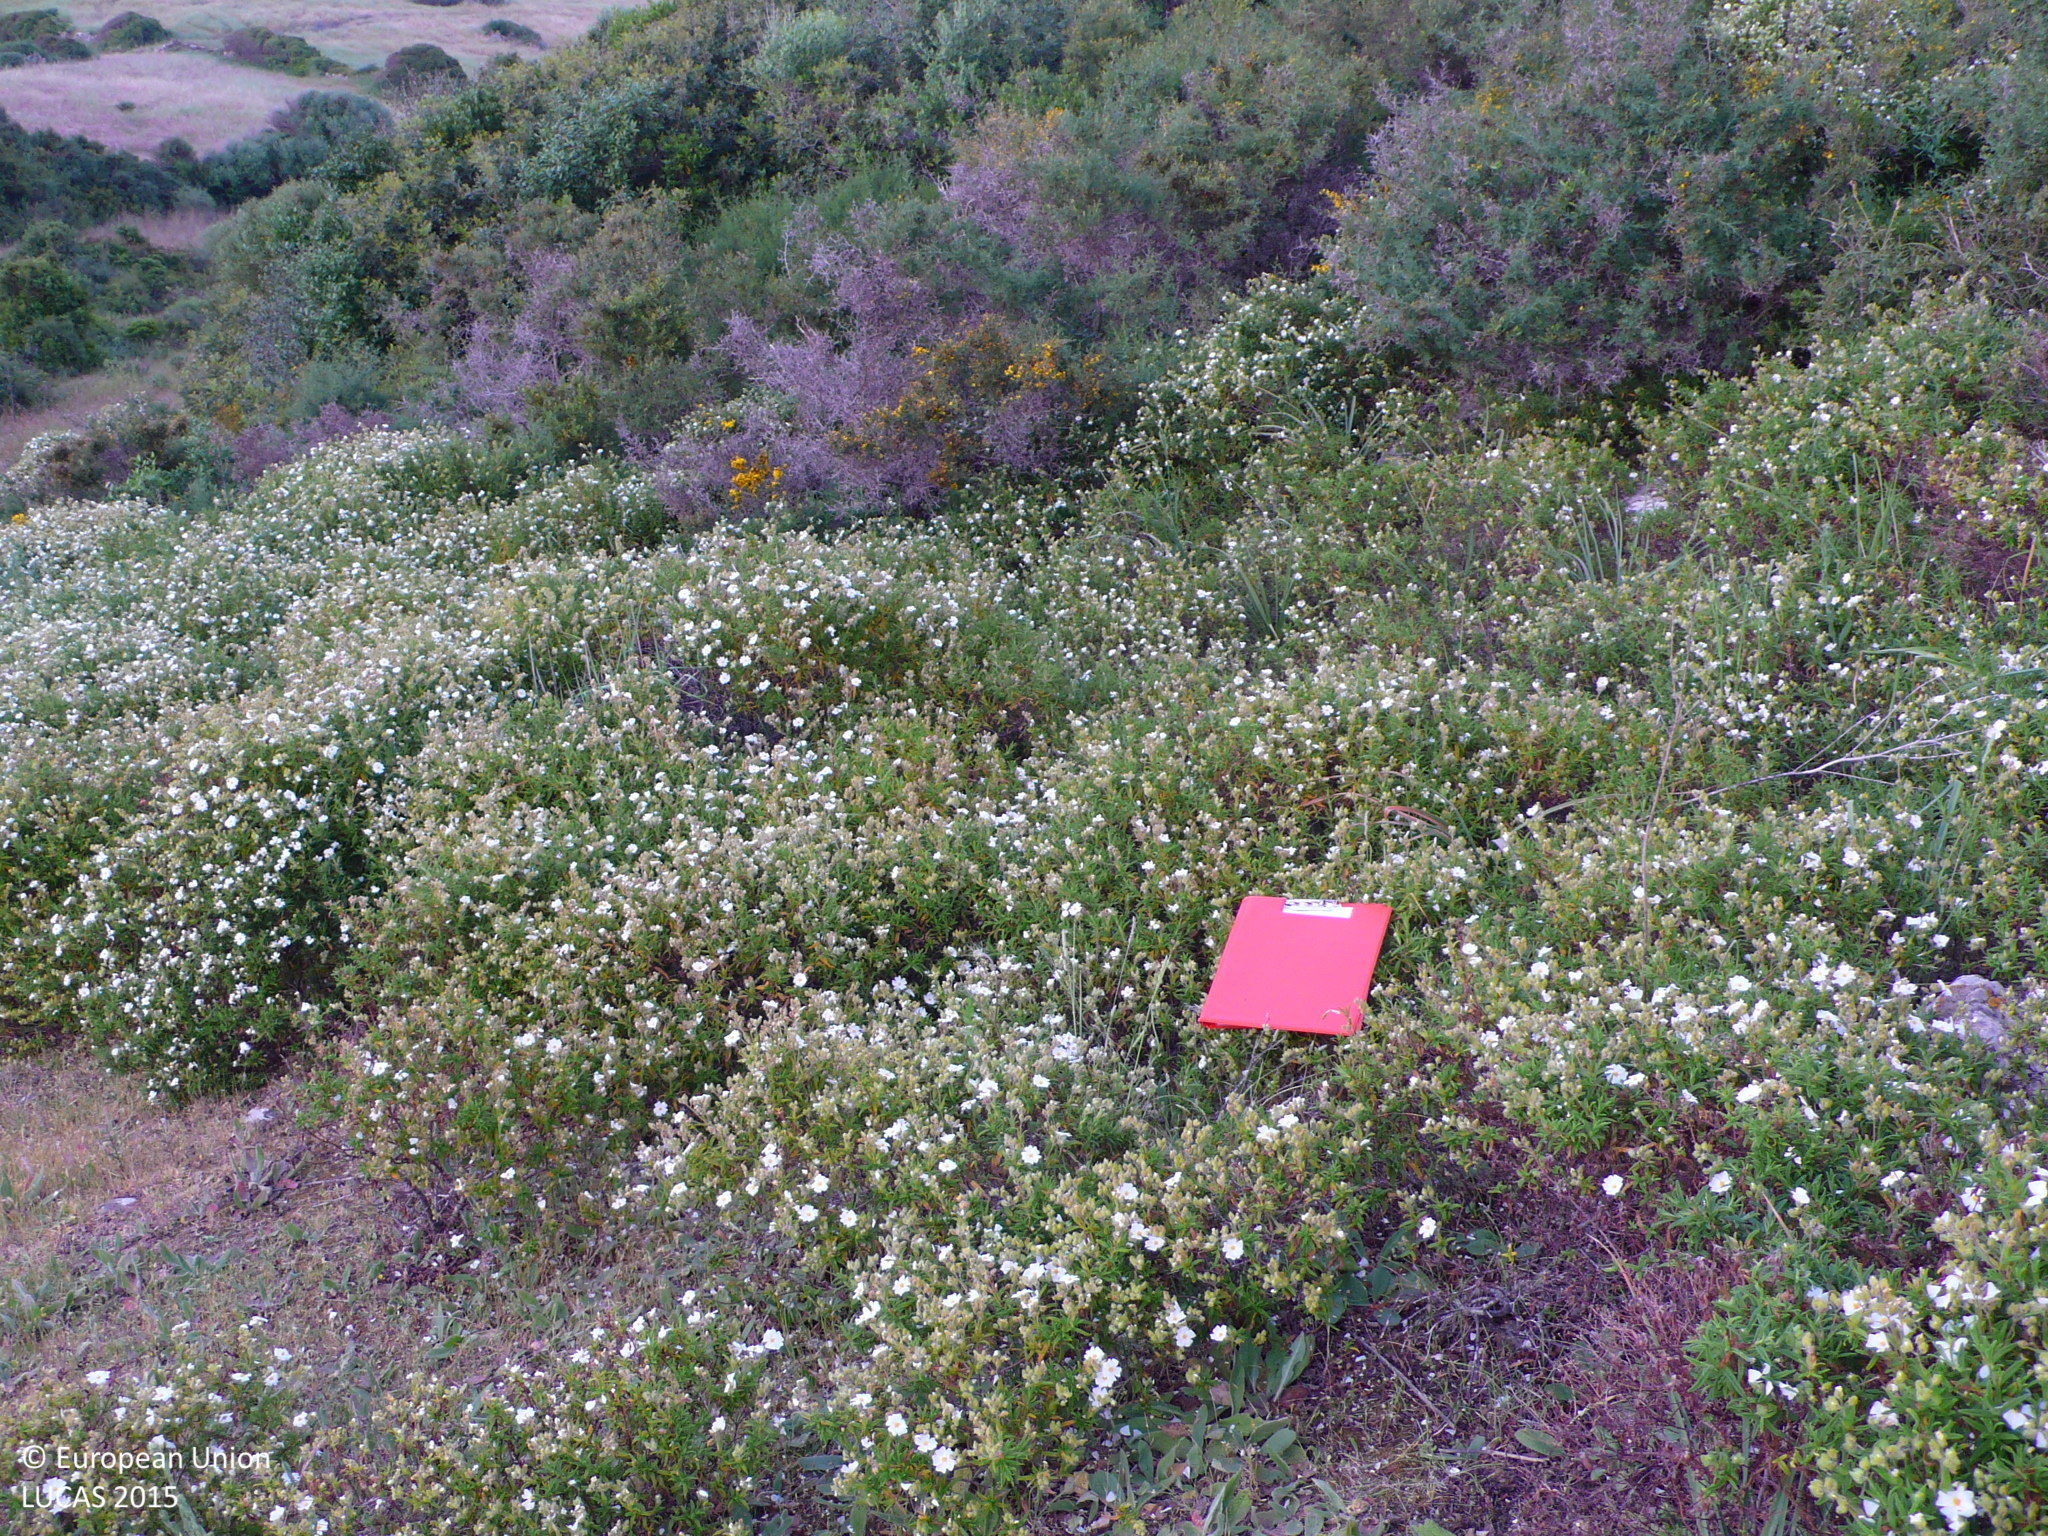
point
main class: Shrubland
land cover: Shrubland without tree cover
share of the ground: 50 - 75 %
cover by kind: shrubs 70 %, herbaceous plants 30 %
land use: Semi-natural and natural areas not in use
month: May
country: ES
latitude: 40.0177
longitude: 4.1090
